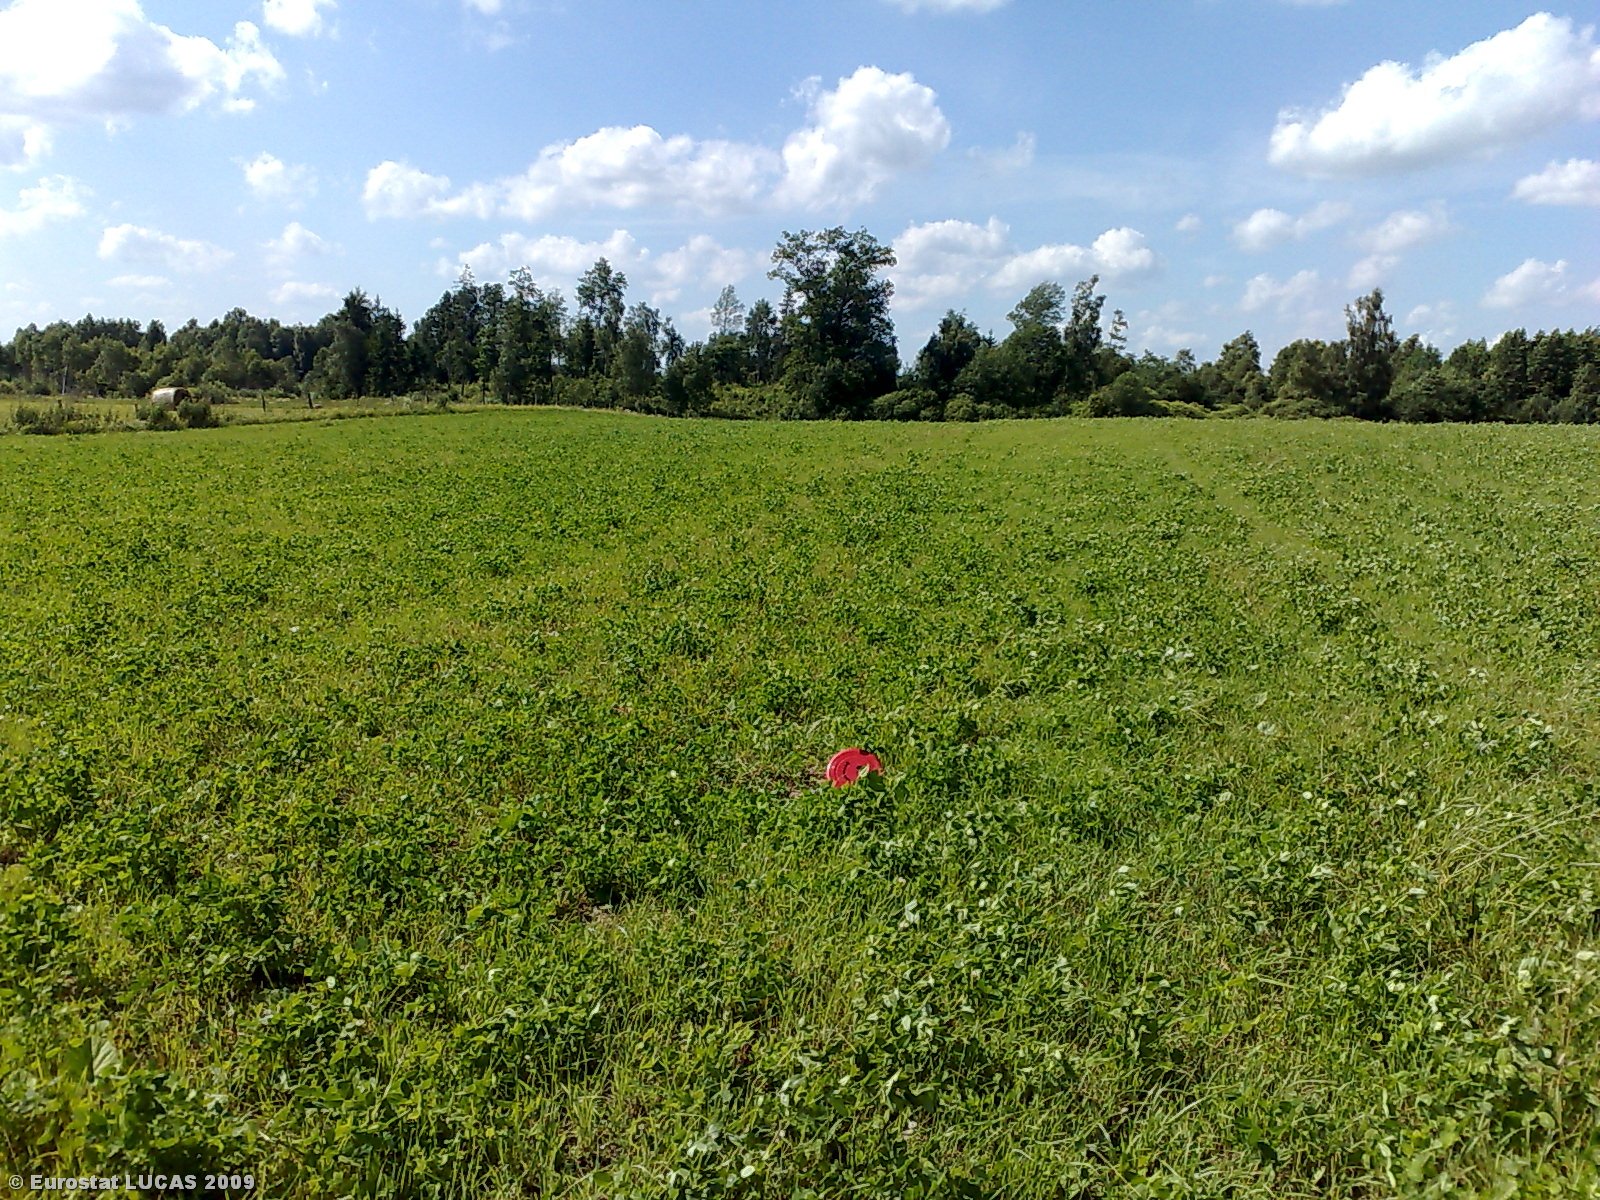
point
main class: Cropland
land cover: Clovers
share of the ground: > 75 %
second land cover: Grassland without tree/shrub cover
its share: 50 - 75 %
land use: Agriculture (excluding fallow land and kitchen gardens)
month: July
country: LT
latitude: 55.5265
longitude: 22.7864
